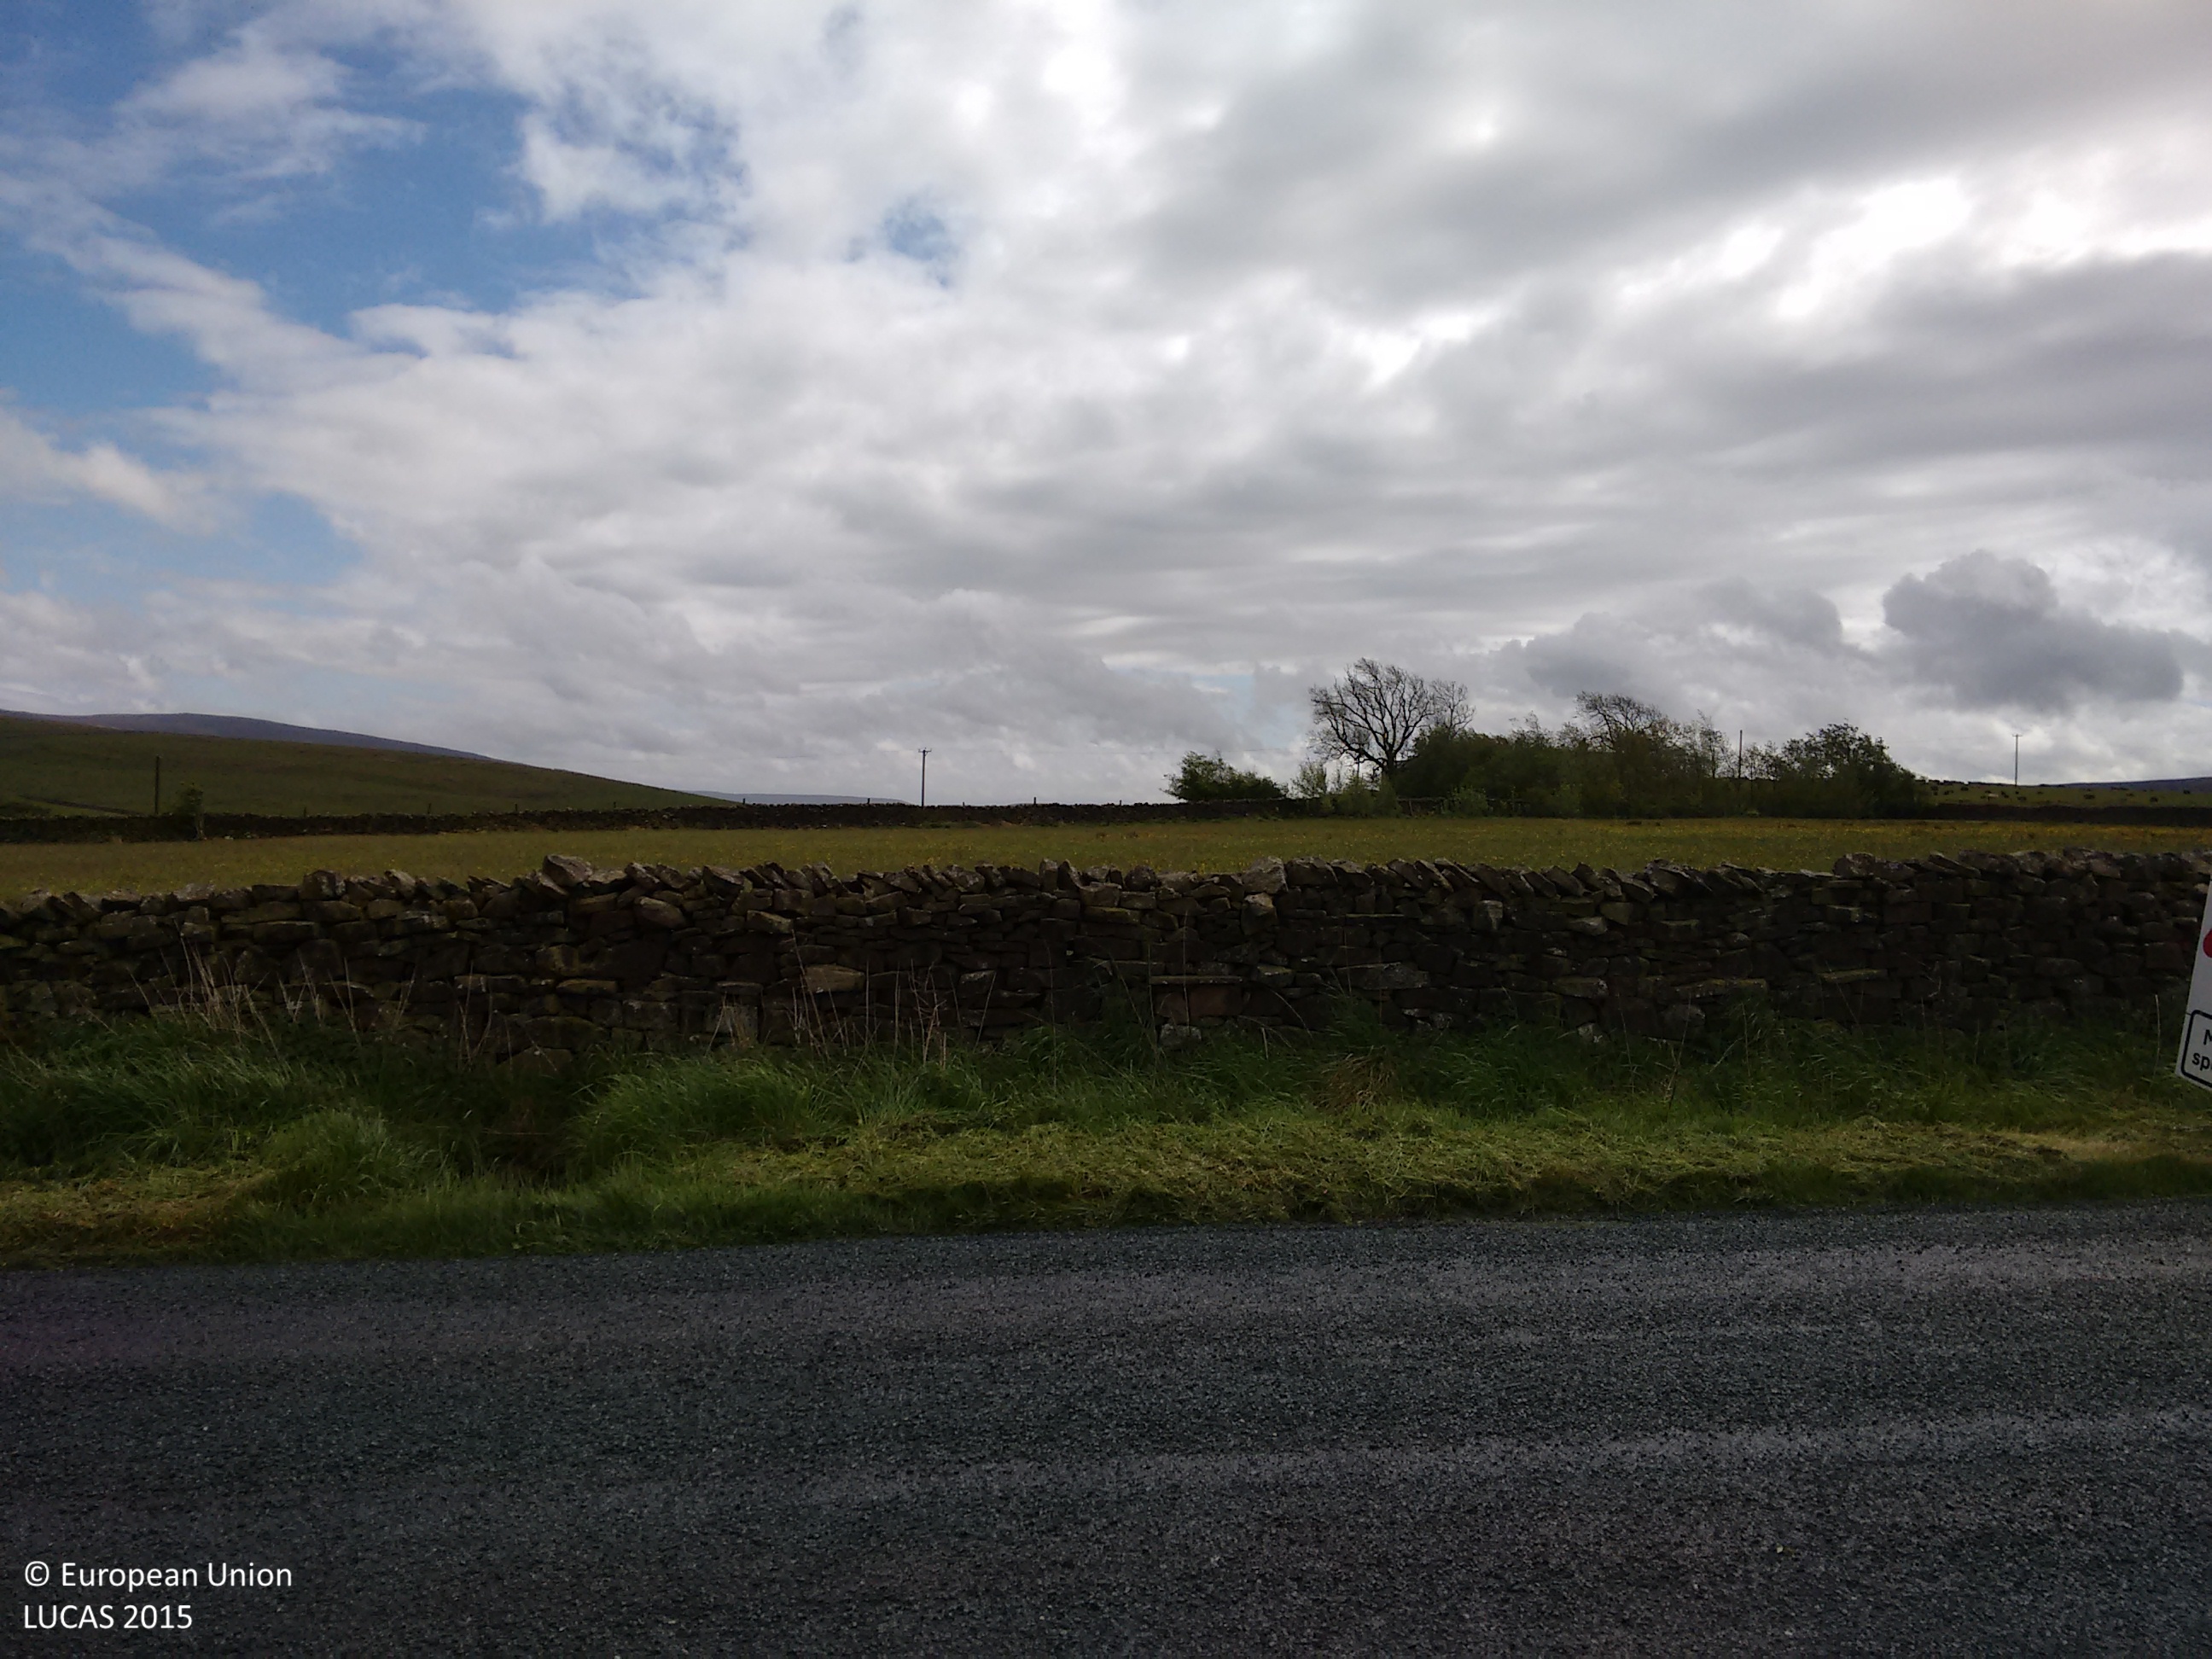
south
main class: Grassland
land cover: Grassland without tree/shrub cover
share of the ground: > 75 %
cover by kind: herbaceous plants 100 %
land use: Agriculture (excluding fallow land and kitchen gardens)
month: June
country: GB
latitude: 54.0646
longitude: -1.9275
